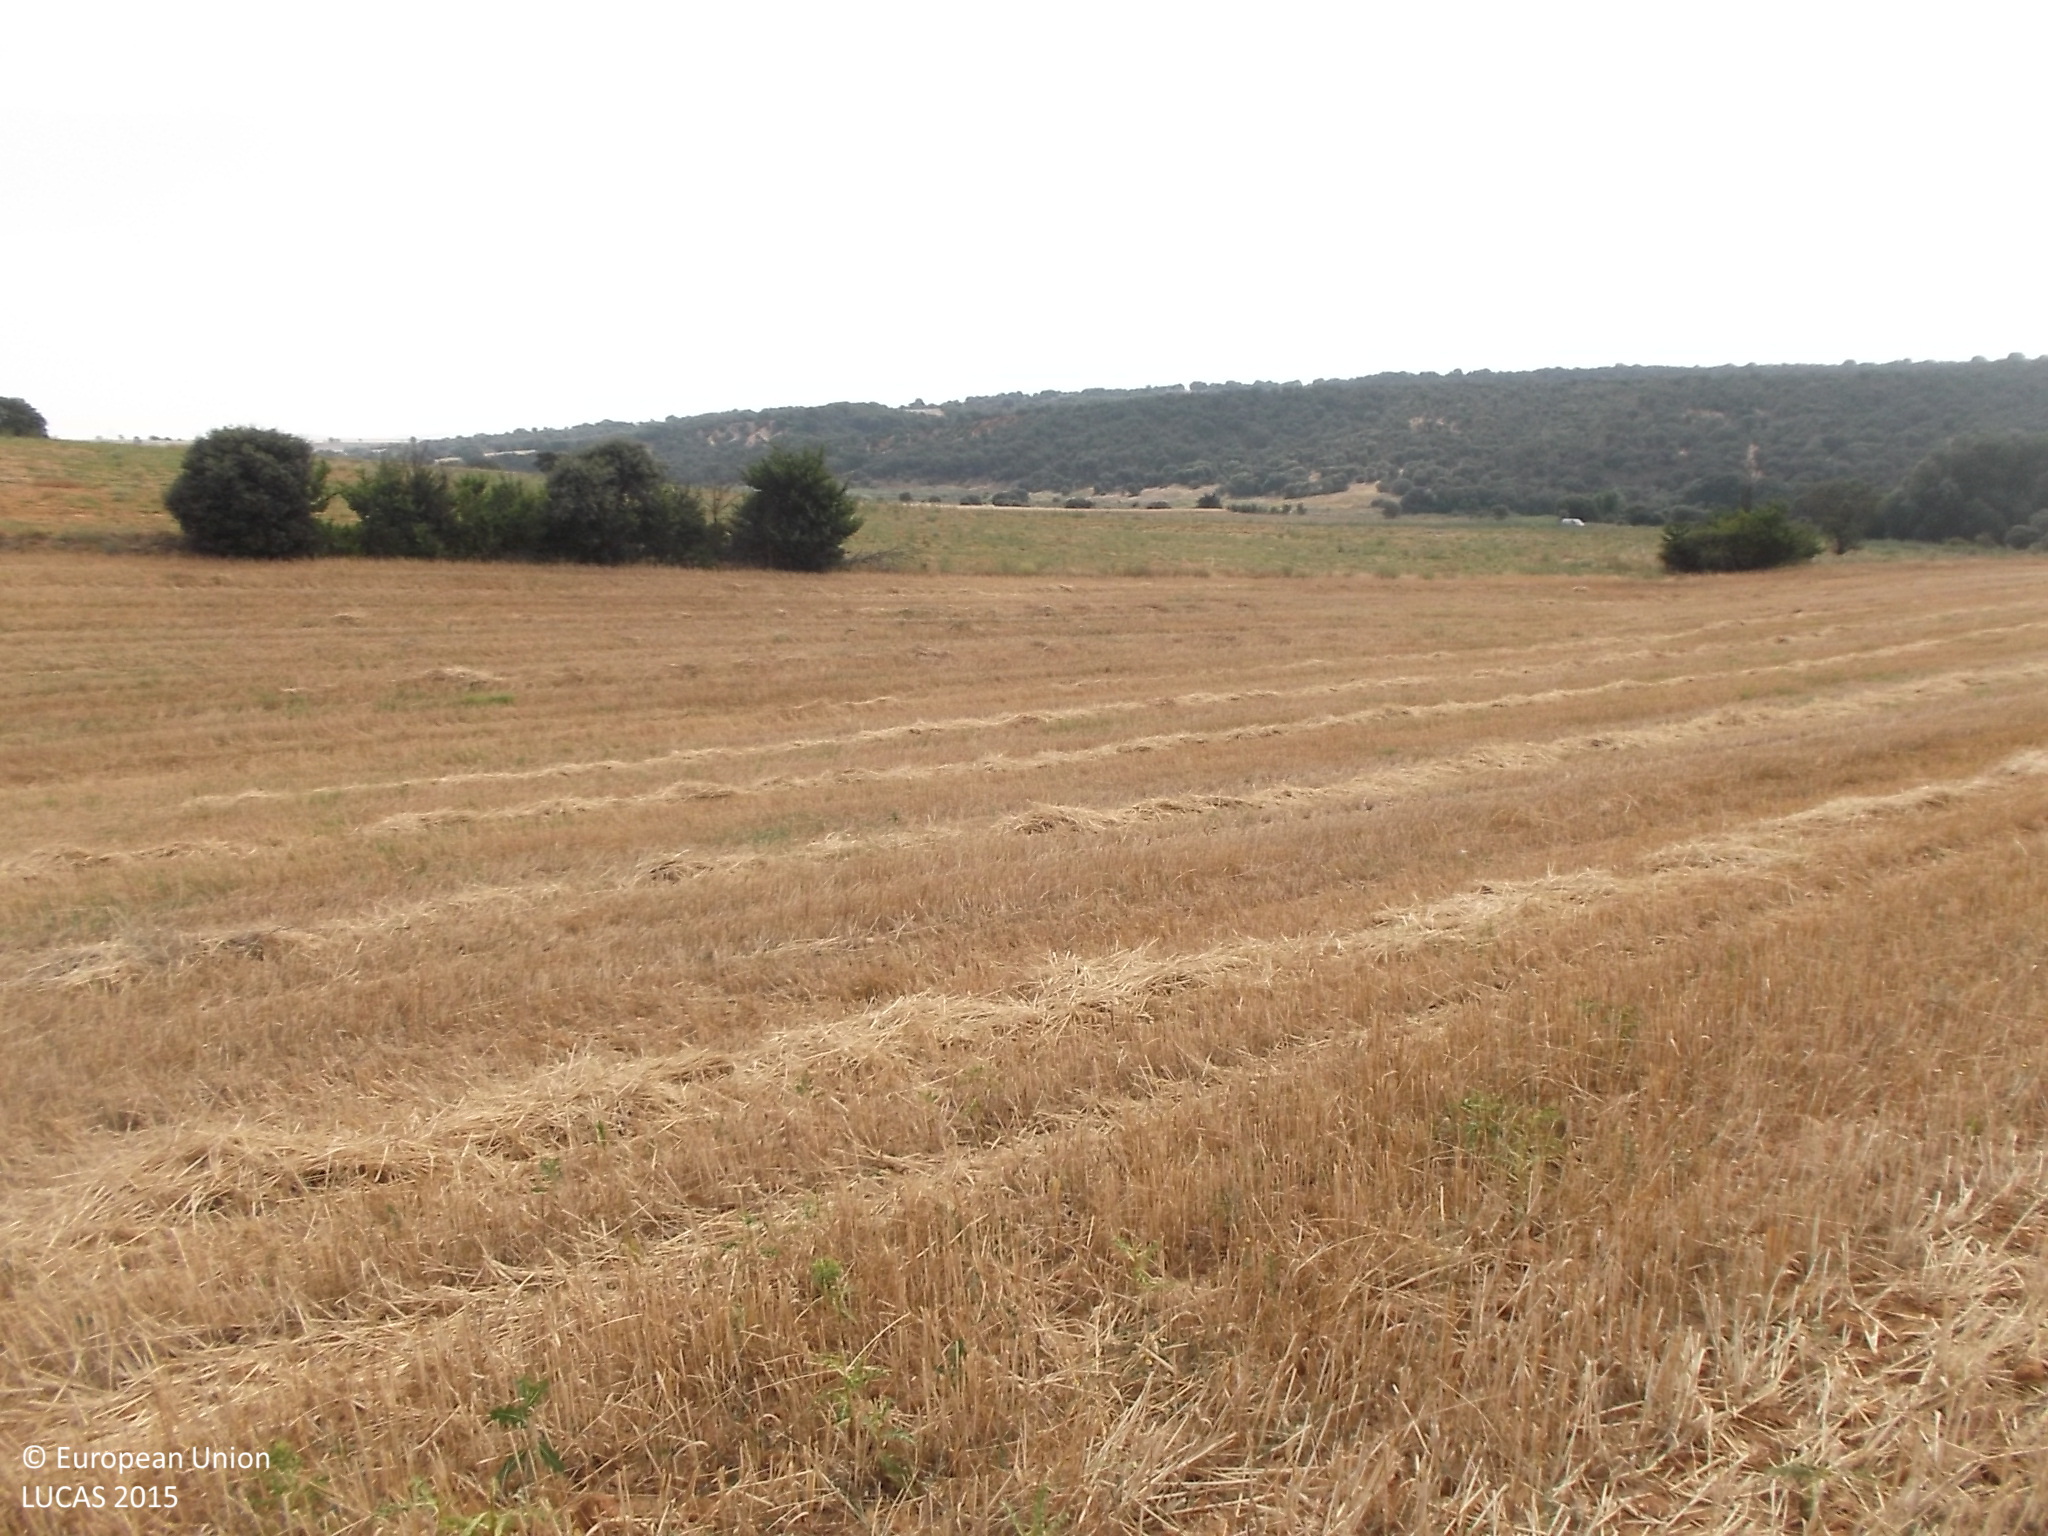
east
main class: Cropland
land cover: Common wheat
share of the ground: < 10 %
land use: Agriculture (excluding fallow land and kitchen gardens)
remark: Harvested field
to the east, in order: Common wheat; Spontaneously vegetated surfaces
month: July
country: ES
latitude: 41.5742
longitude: -5.5425
